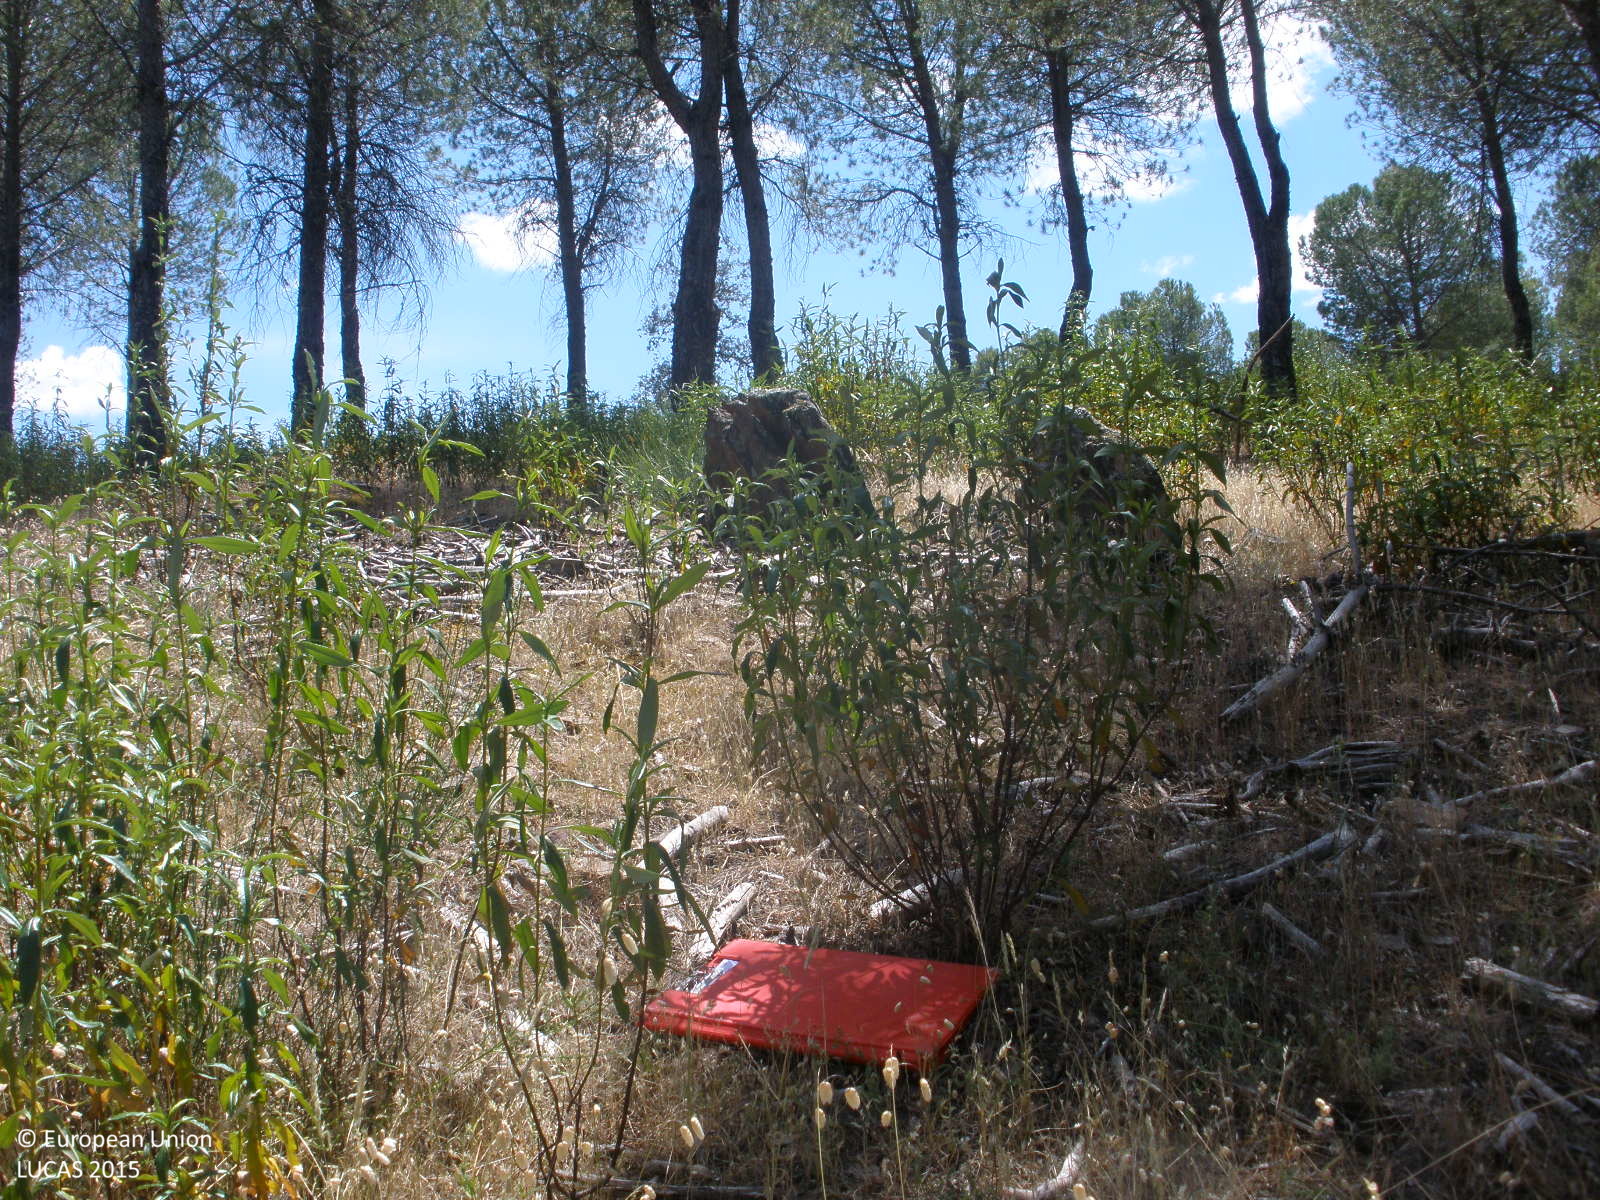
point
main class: Woodland
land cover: Pine dominated coniferous woodland
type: coniferous forest of the mediterranean region
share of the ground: 50 - 75 %
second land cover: Shrubland without tree cover
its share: 10 - 25 %
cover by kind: coniferous forest trees 50 %, shrubs 30 %, herbaceous plants 20 %
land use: Forestry
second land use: Agriculture (excluding fallow land and kitchen gardens)
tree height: > 5 m
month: May
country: ES
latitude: 40.2743
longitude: -6.0812
